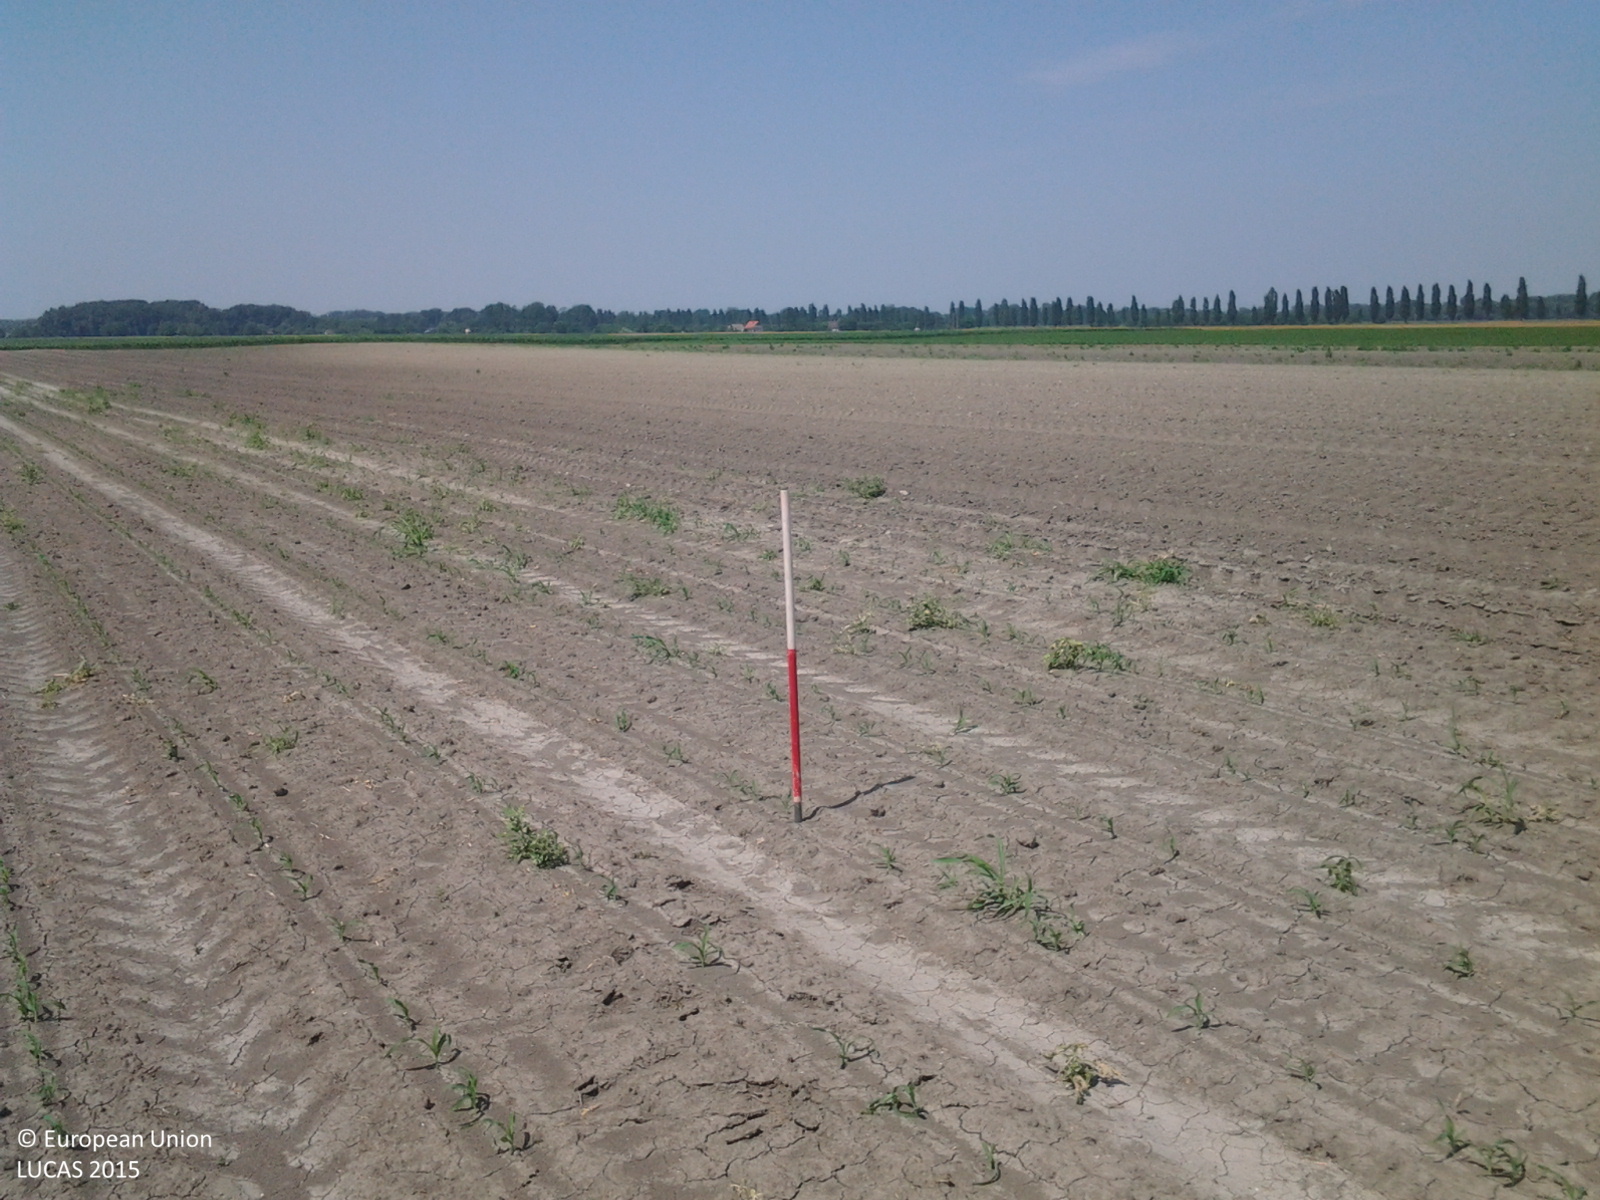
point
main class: Cropland
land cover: Maize
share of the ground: > 75 %
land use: Agriculture (excluding fallow land and kitchen gardens)
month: June
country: HU
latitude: 46.5017
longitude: 18.9392
